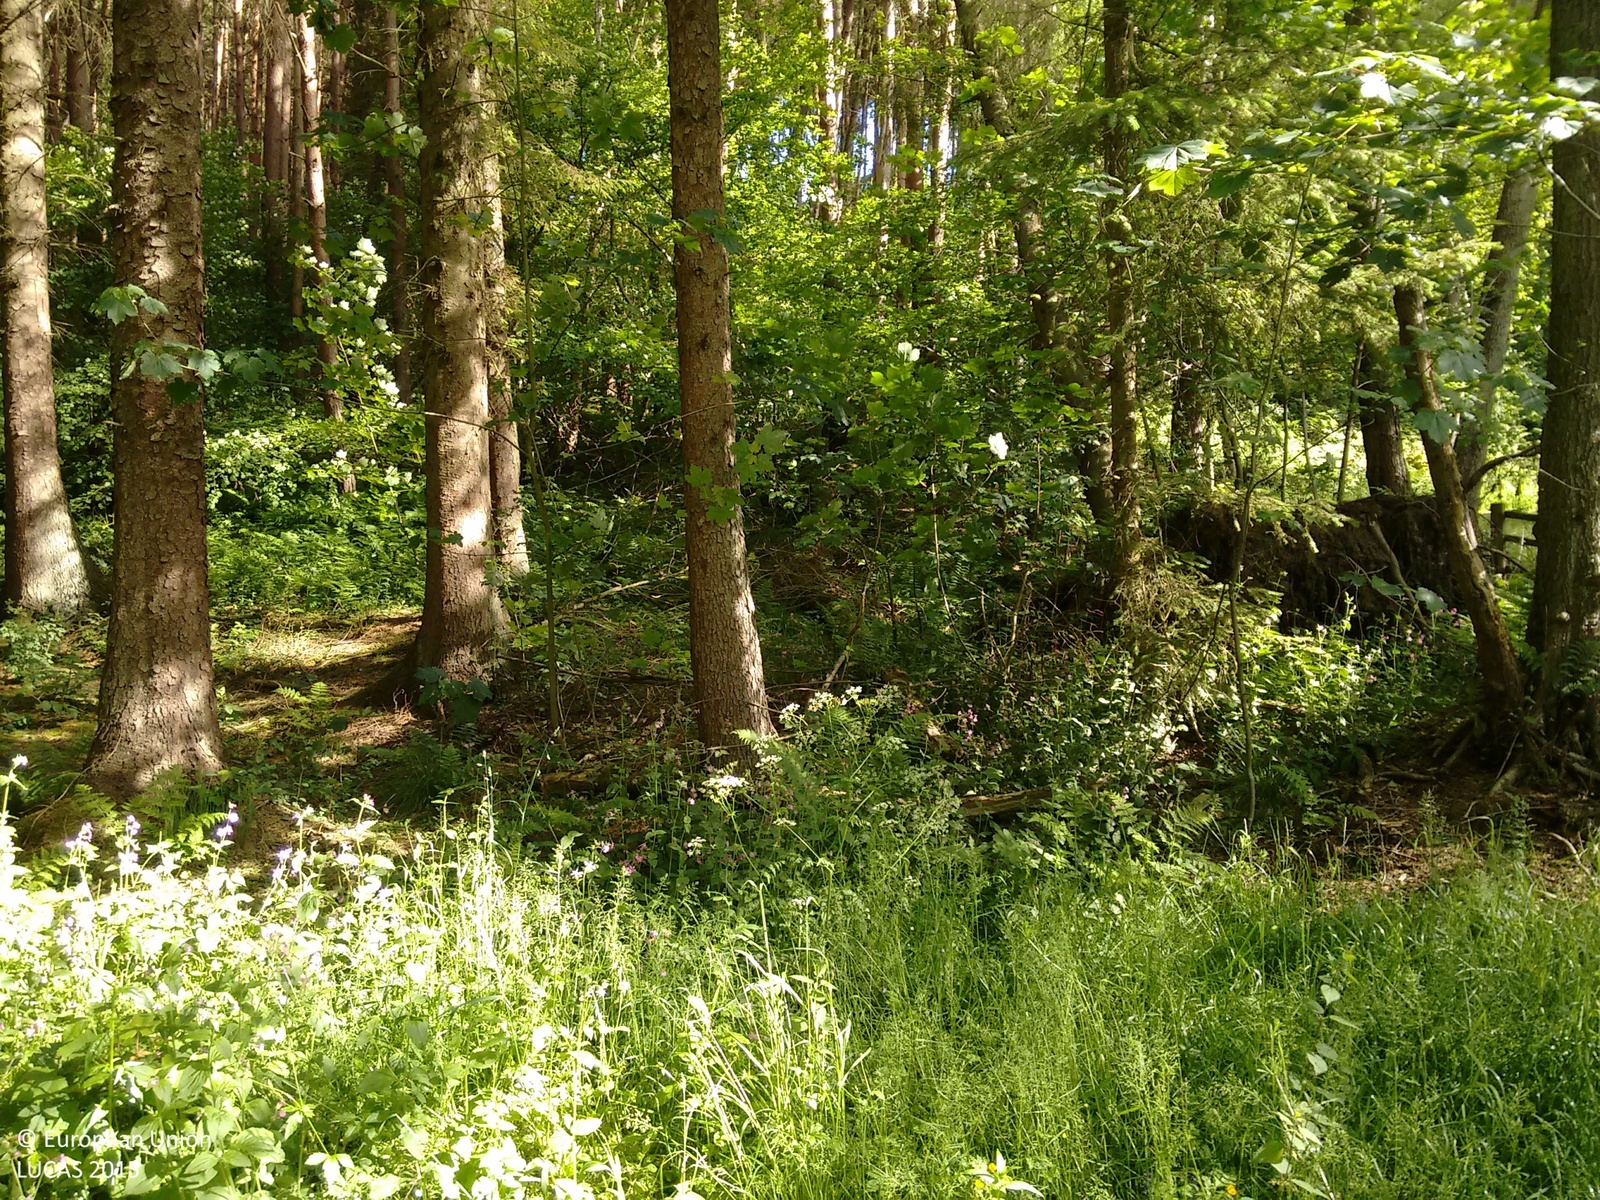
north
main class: Woodland
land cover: Broadleaved woodland
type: mesophytic deciduous forest
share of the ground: > 75 %
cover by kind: broadleaved forest trees 80 %, coniferous forest trees 20 %
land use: Sport
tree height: > 5 m
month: June
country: GB
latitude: 54.1471
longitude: -1.0507
